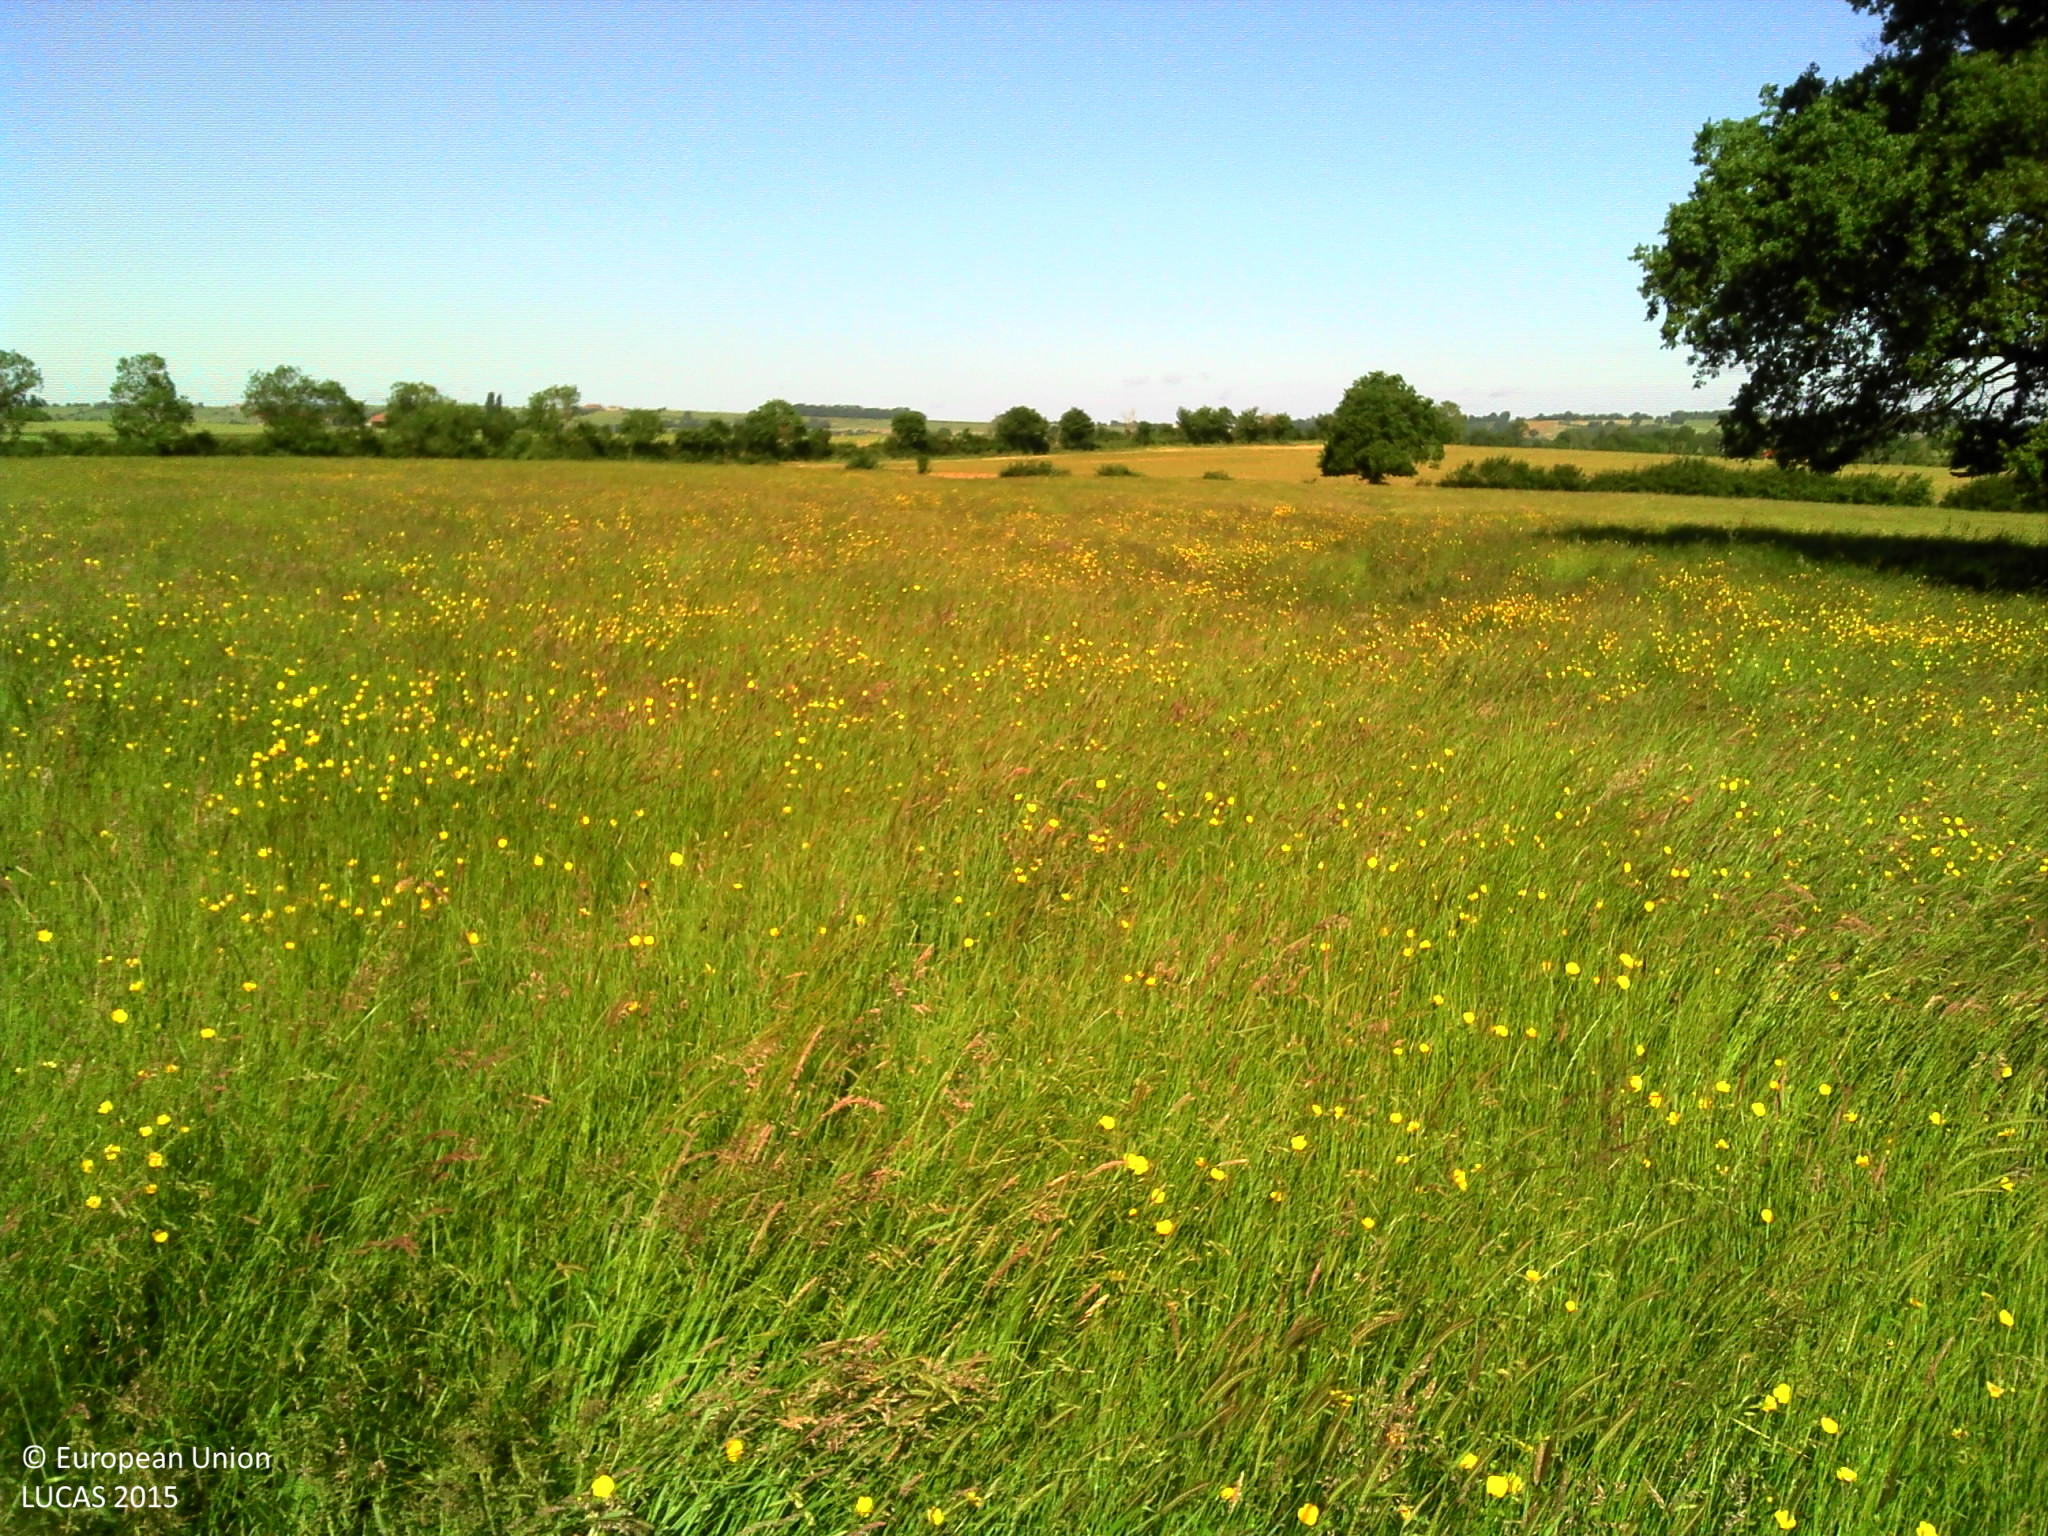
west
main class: Grassland
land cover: Grassland without tree/shrub cover
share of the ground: > 75 %
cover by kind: herbaceous plants 100 %
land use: Agriculture (excluding fallow land and kitchen gardens)
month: June
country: FR
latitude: 46.9654
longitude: 2.9115
